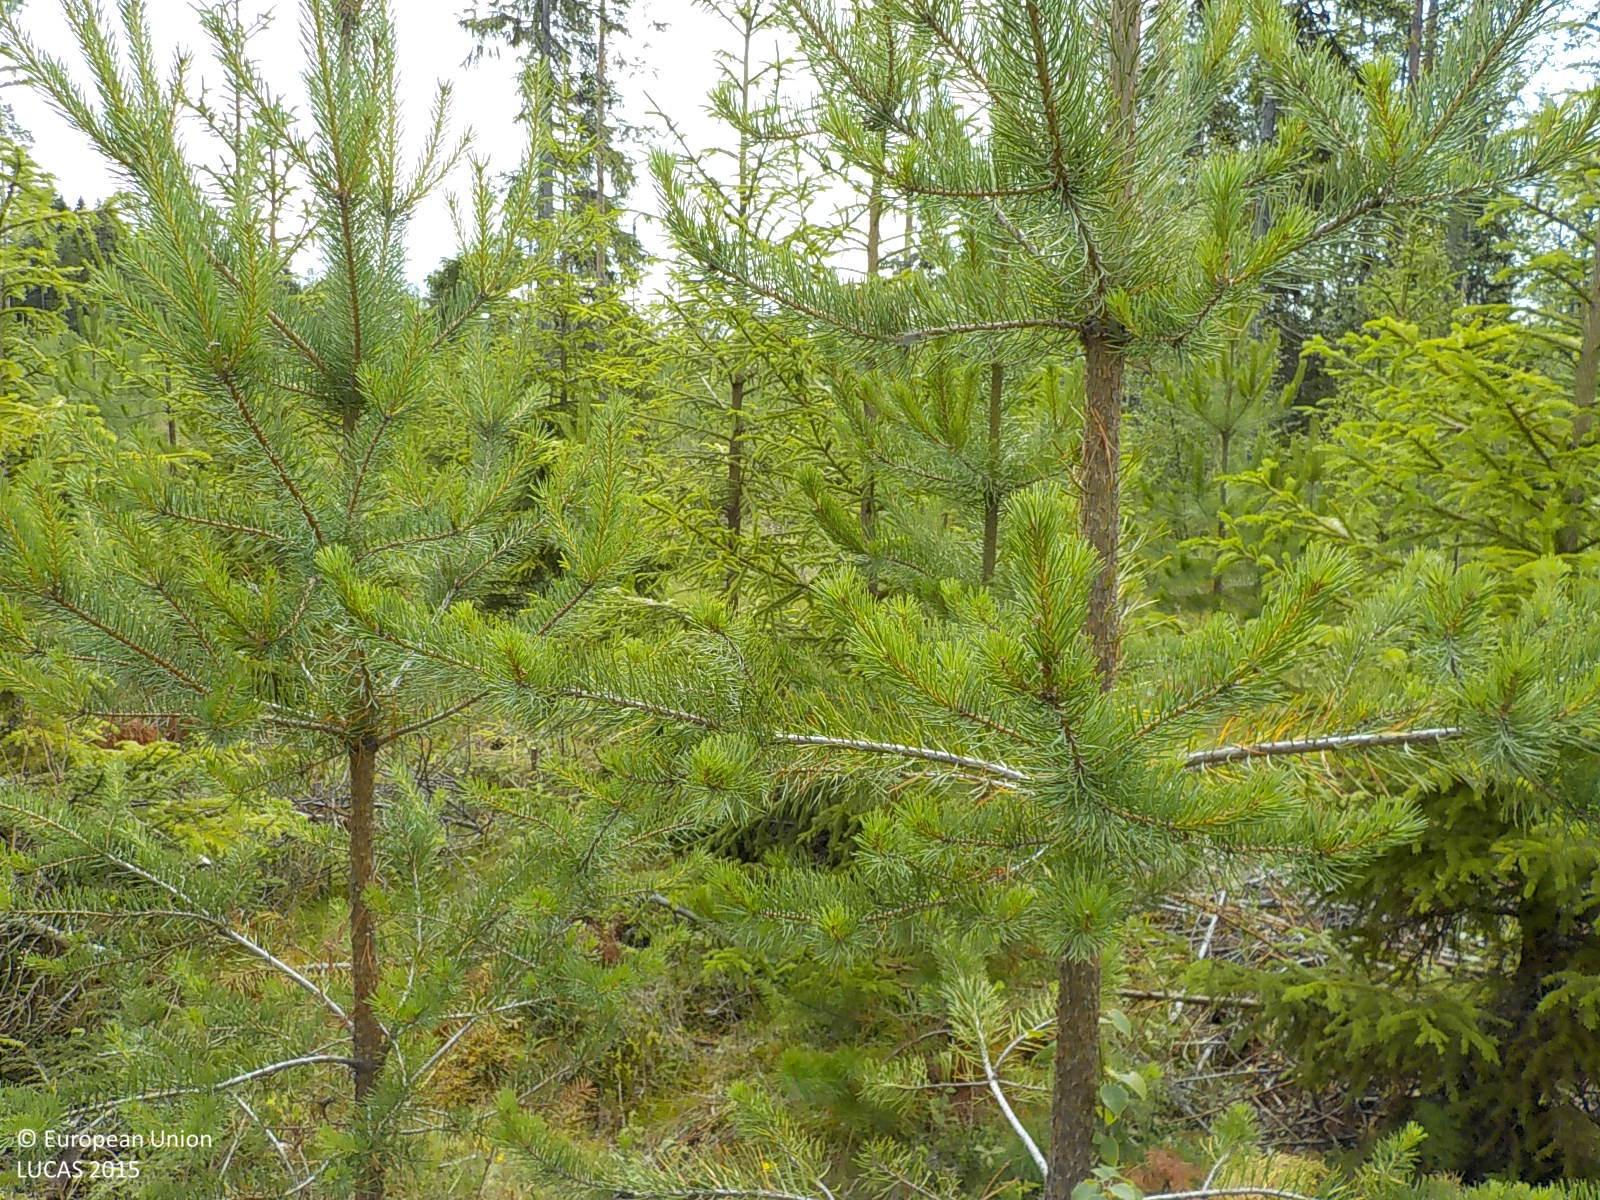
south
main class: Woodland
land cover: Pine dominated coniferous woodland
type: boreal forest
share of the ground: 50 - 75 %
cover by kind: coniferous forest trees 50 %, herbaceous plants 40 %, broadleaved forest trees 5 %, shrubs 5 %
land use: Forestry
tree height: < 5 m
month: July
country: SE
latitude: 63.1977
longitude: 17.2709
